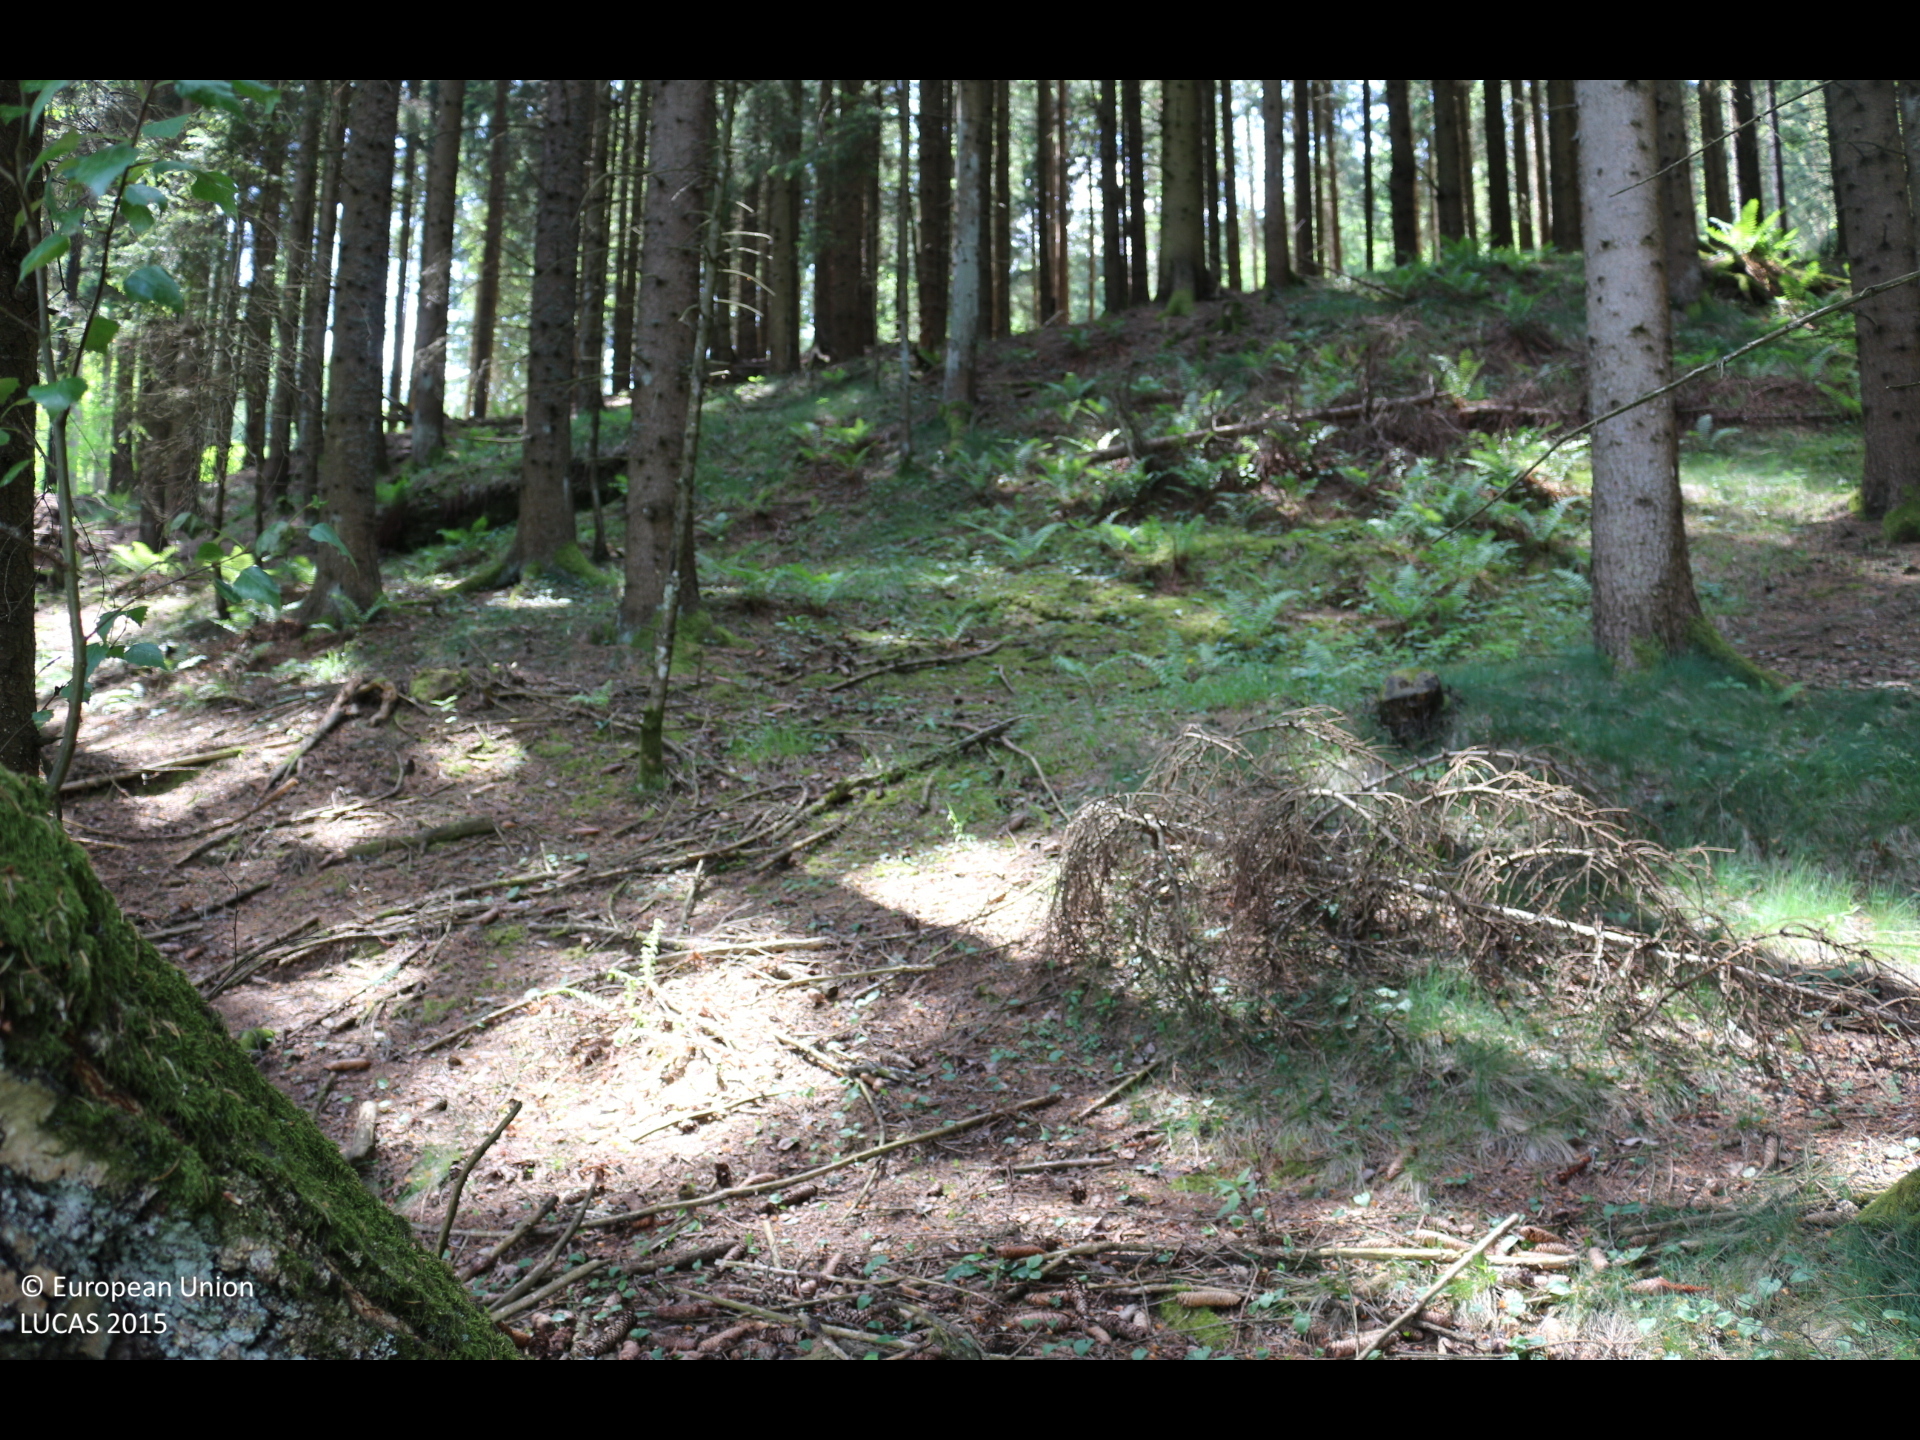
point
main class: Woodland
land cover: Spruce dominated coniferous woodland
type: alpine coniferous forest
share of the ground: > 75 %
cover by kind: coniferous forest trees 100 %
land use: Forestry
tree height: > 5 m
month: May
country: AT
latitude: 46.7706
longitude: 14.2798
